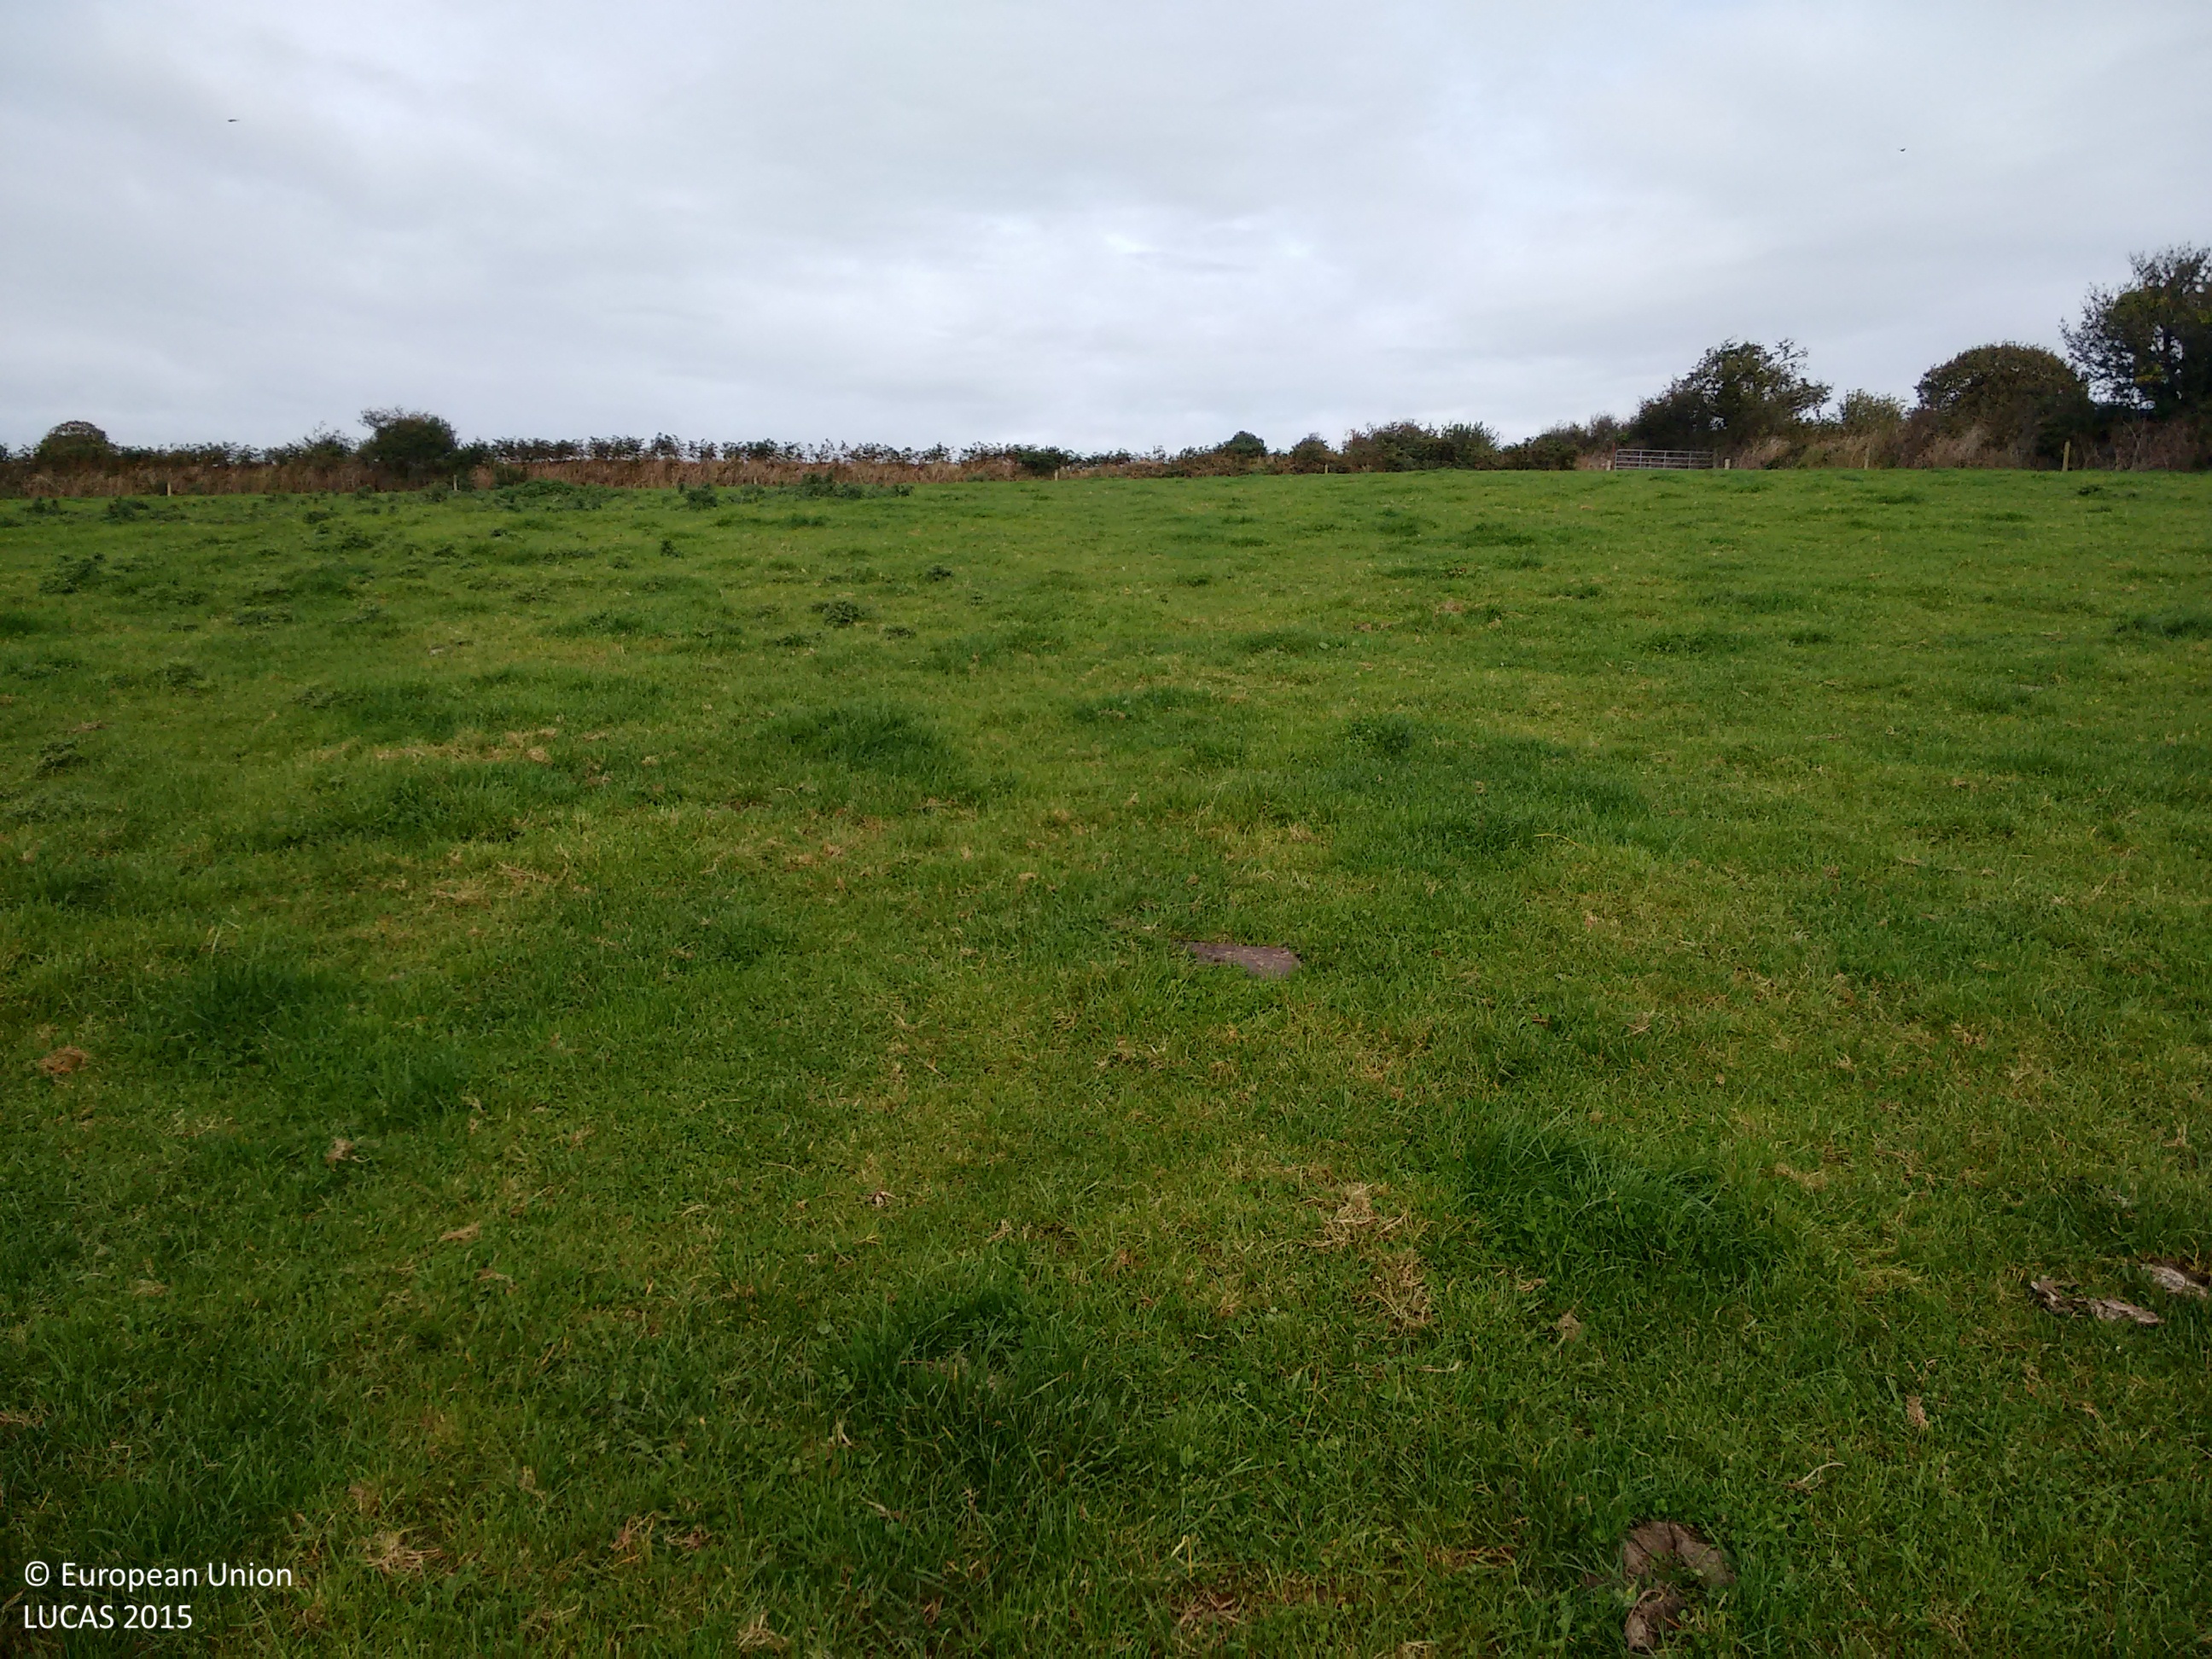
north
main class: Grassland
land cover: Grassland without tree/shrub cover
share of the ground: > 75 %
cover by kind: herbaceous plants 100 %
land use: Agriculture (excluding fallow land and kitchen gardens)
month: October
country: IE
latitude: 51.9602
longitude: -8.3657
